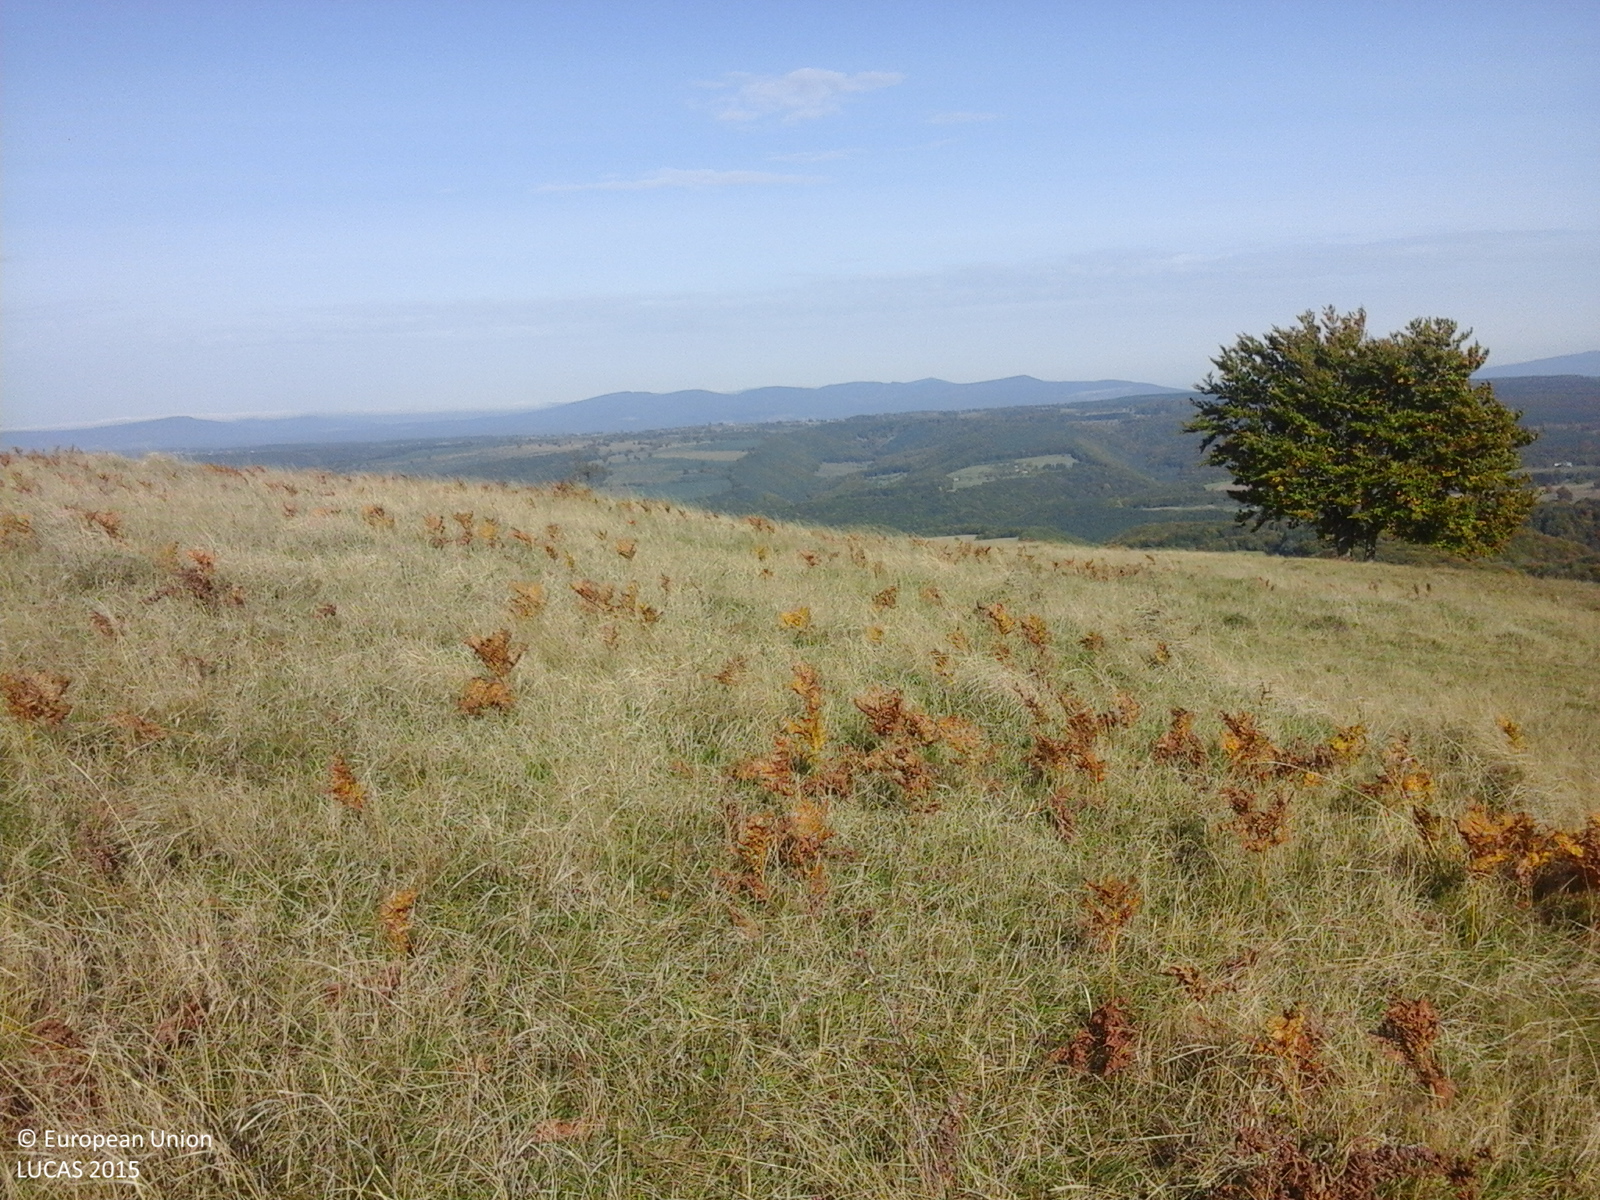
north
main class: Grassland
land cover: Grassland without tree/shrub cover
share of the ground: > 75 %
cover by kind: herbaceous plants 100 %
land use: Agriculture (excluding fallow land and kitchen gardens)
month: October
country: RO
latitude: 46.4314
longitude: 25.1841
